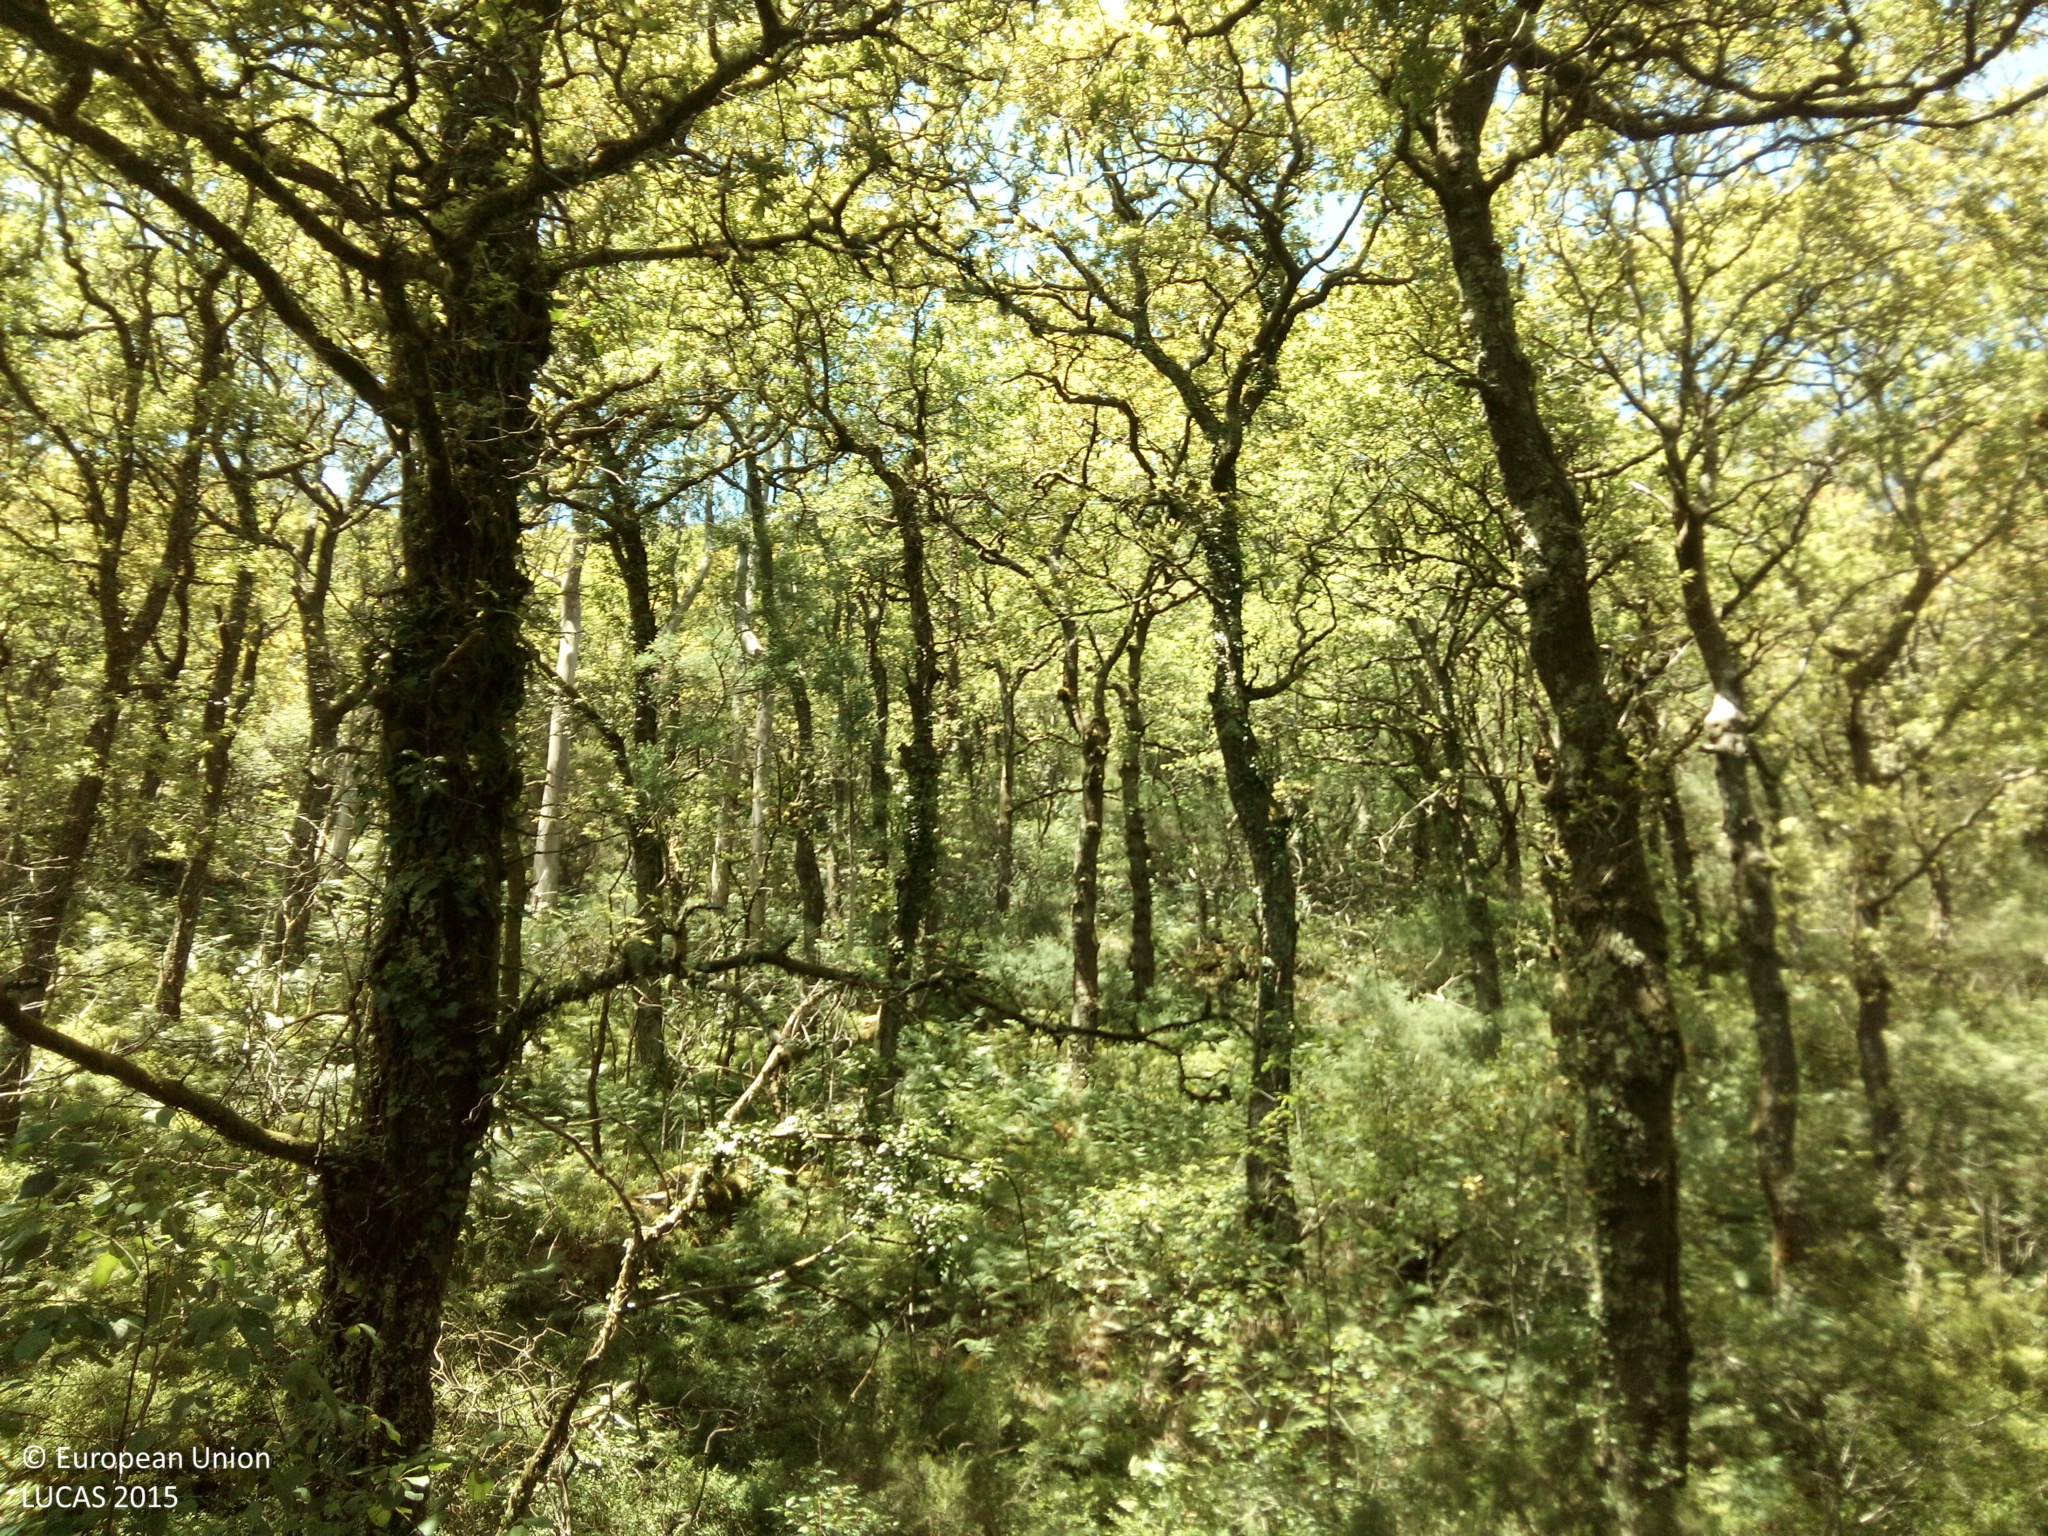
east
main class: Woodland
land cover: Broadleaved woodland
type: acidophilous oak and oak-birch forest
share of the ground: > 75 %
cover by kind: broadleaved forest trees 100 %
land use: Forestry
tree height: > 5 m
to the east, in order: Broadleaved woodland; Dry stone walls; Rivers and streams; Artificial constructions; Groves; Grassland without tree/shrub cover; Dry stone walls; Grassland without tree/shrub cover; Fences; Abandoned hedges; Grassland without tree/shrub cover; Dry stone walls; Ditches and canals; Tracks; Dry stone walls; Abandoned hedges; Fences; Grassland without tree/shrub cover; Broadleaved woodland
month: June
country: ES
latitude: 42.4618
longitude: -8.4221
